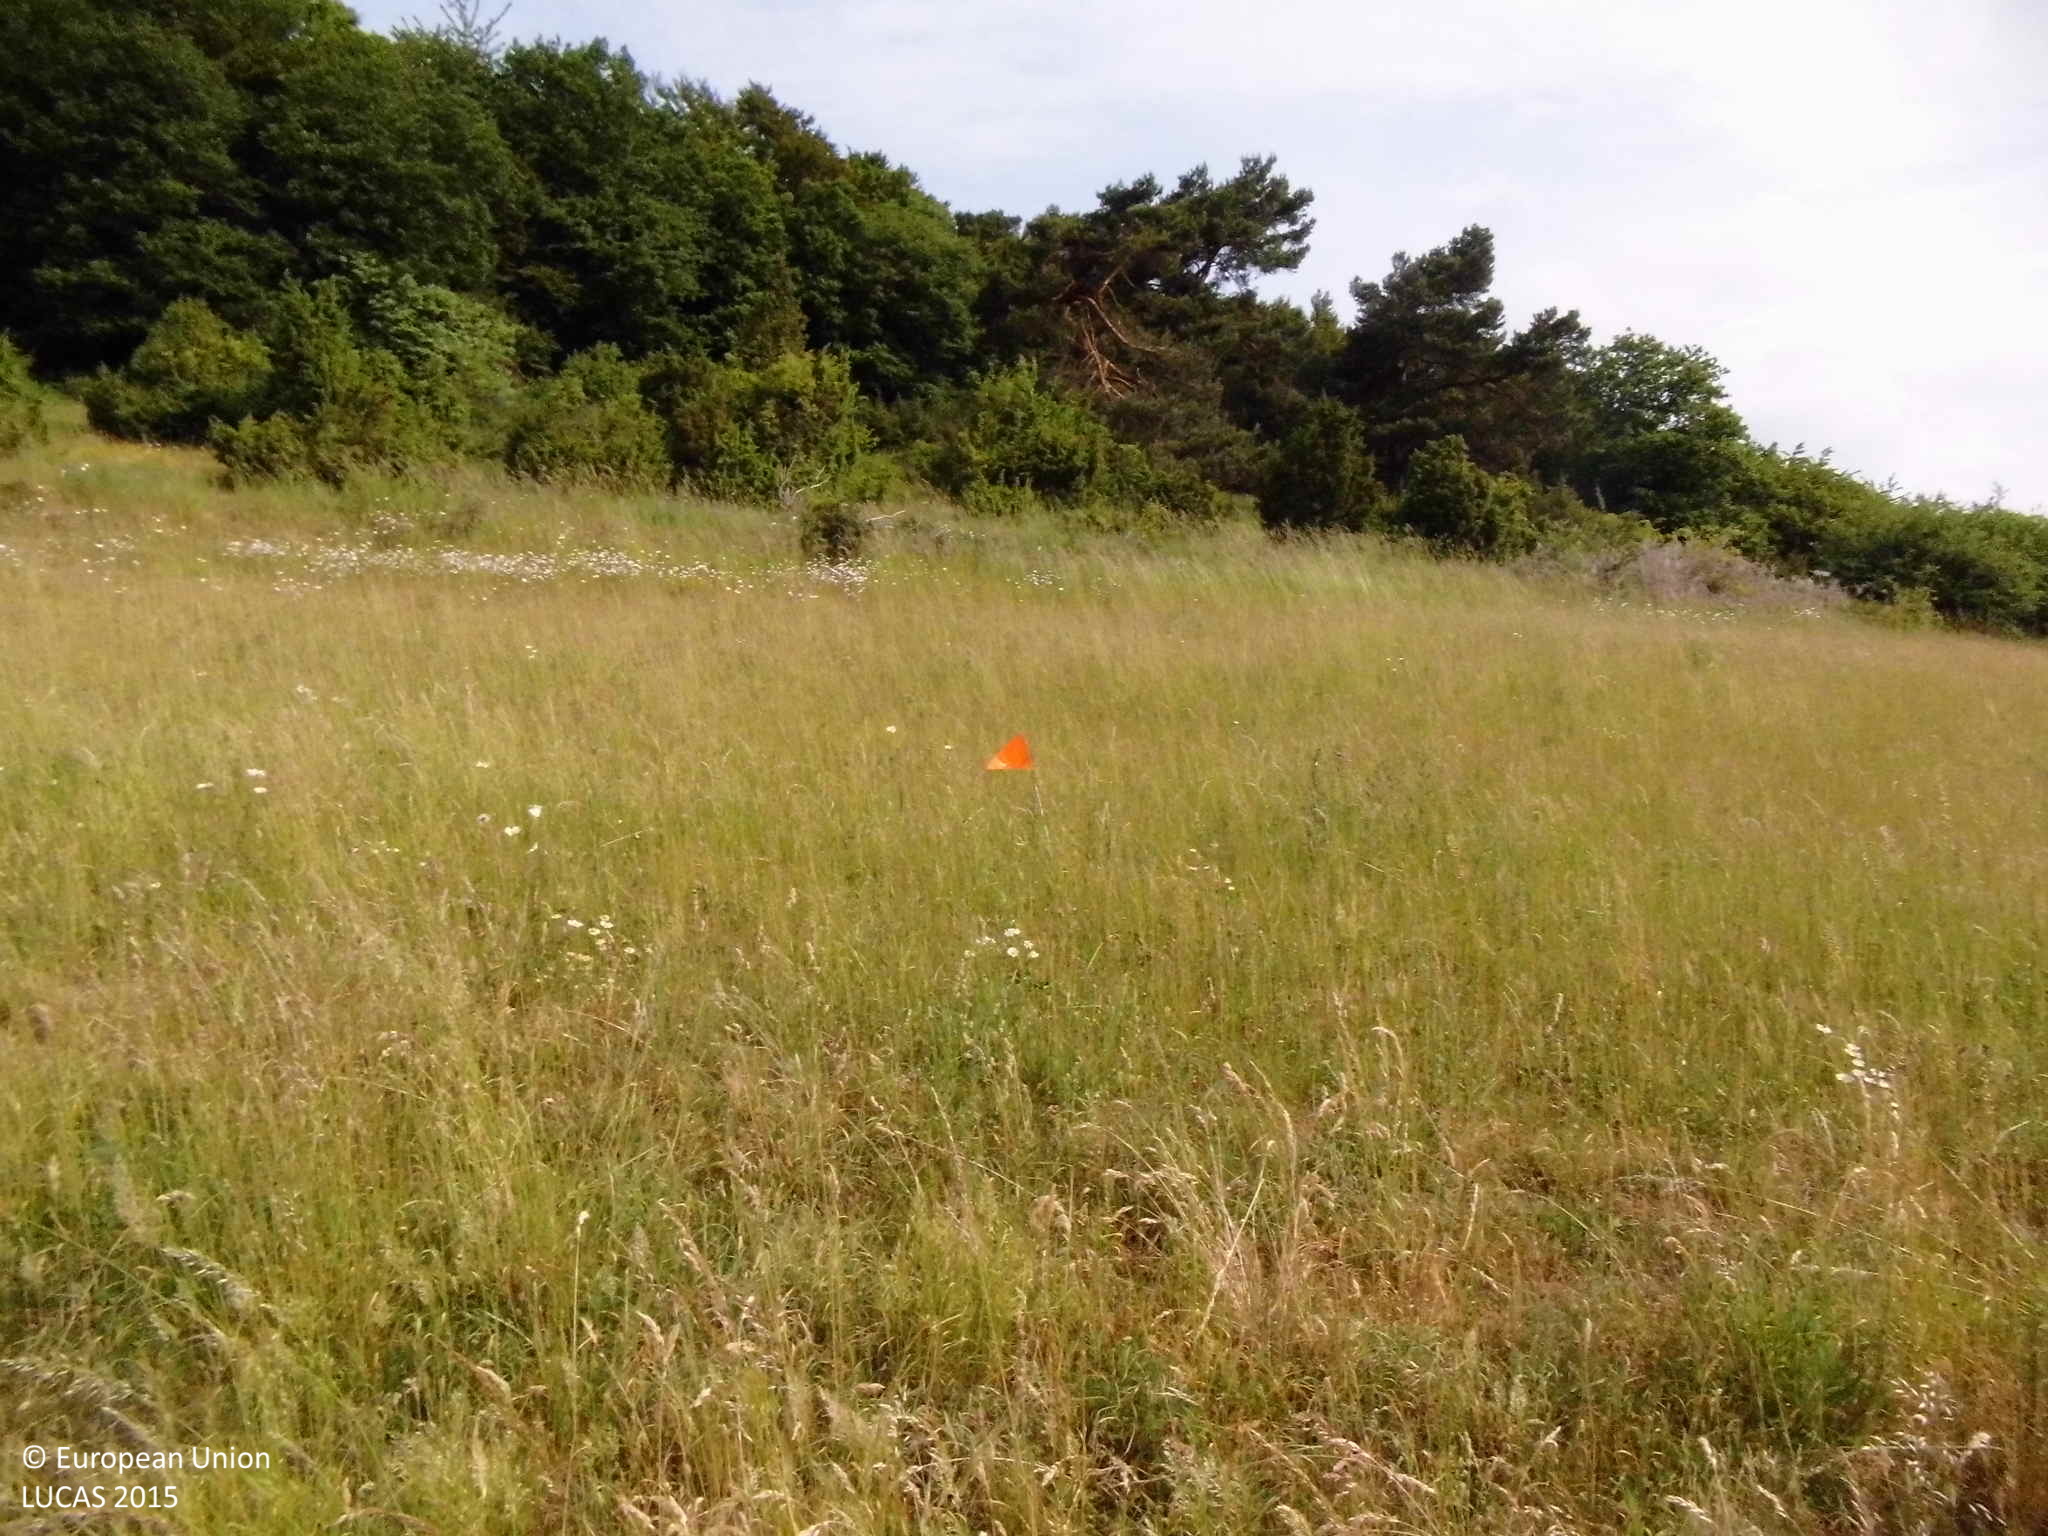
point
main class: Grassland
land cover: Grassland without tree/shrub cover
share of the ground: > 75 %
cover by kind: herbaceous plants 100 %
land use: Agriculture (excluding fallow land and kitchen gardens)
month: June
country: DE
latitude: 50.7672
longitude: 8.4549
